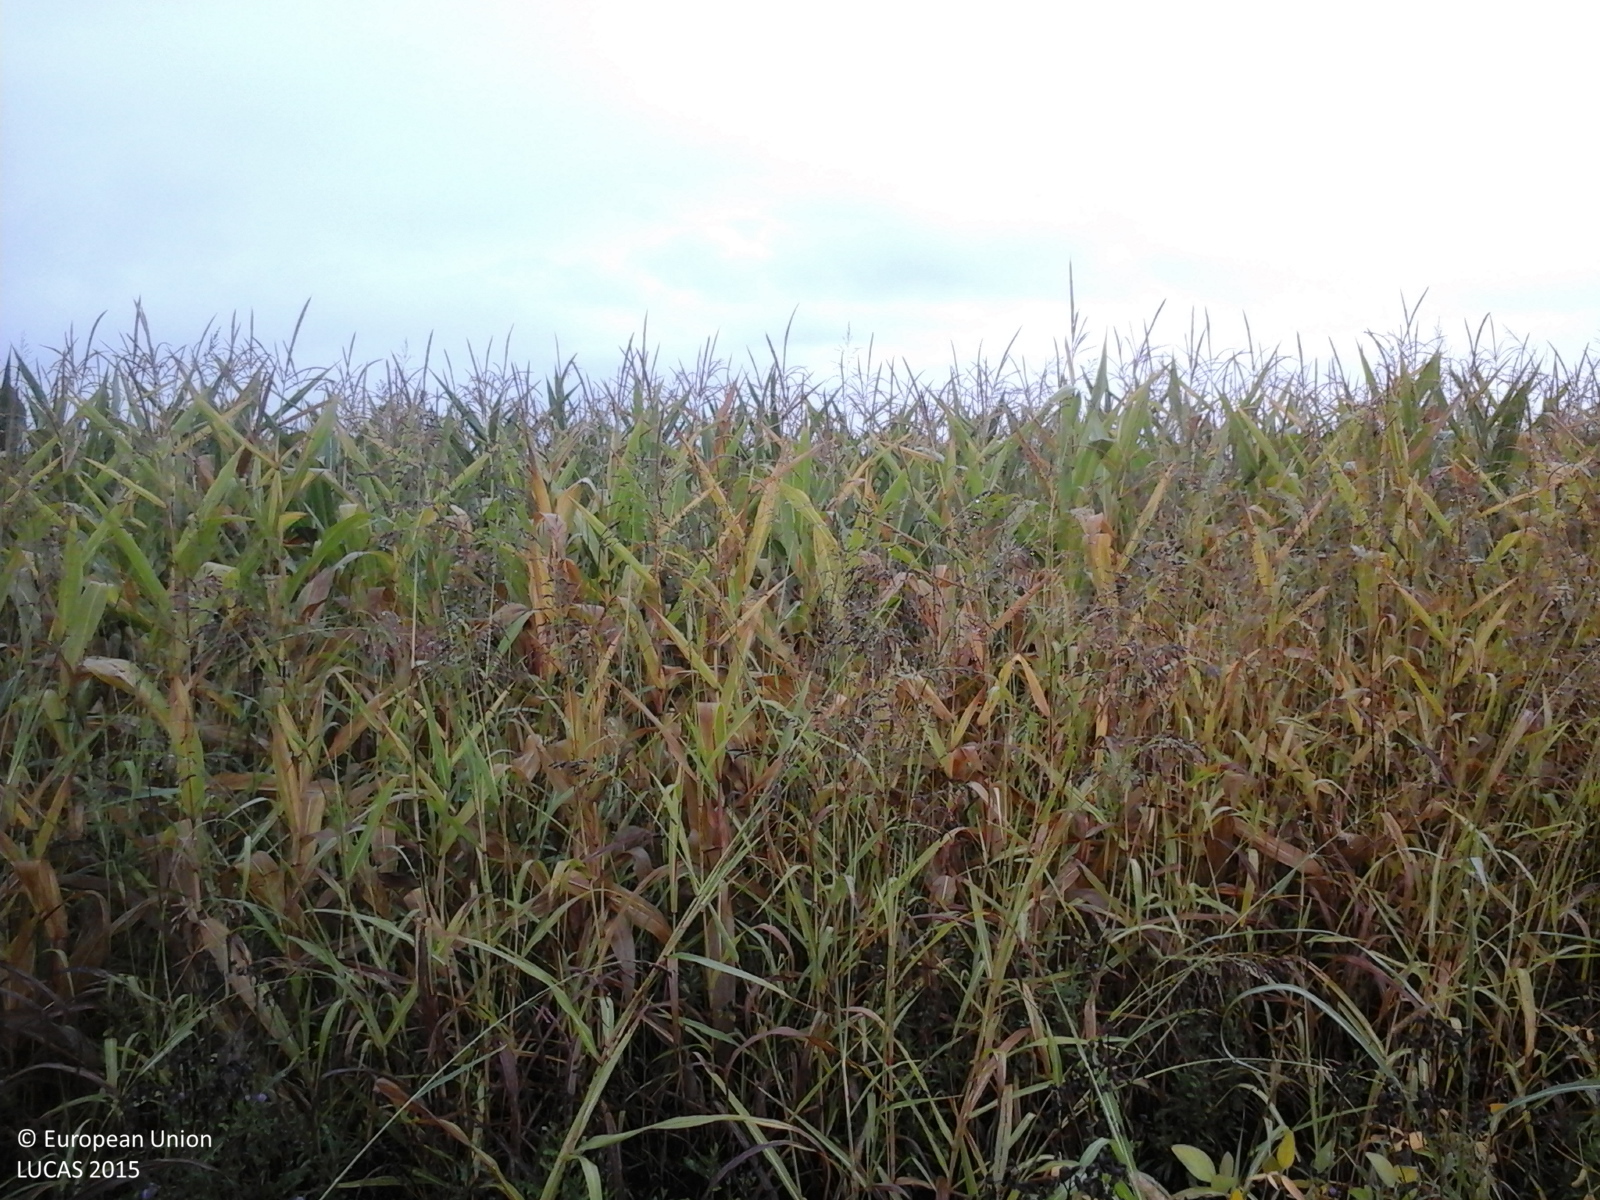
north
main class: Cropland
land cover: Maize
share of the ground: > 75 %
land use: Agriculture (excluding fallow land and kitchen gardens)
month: August
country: RO
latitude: 45.9356
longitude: 20.7441
